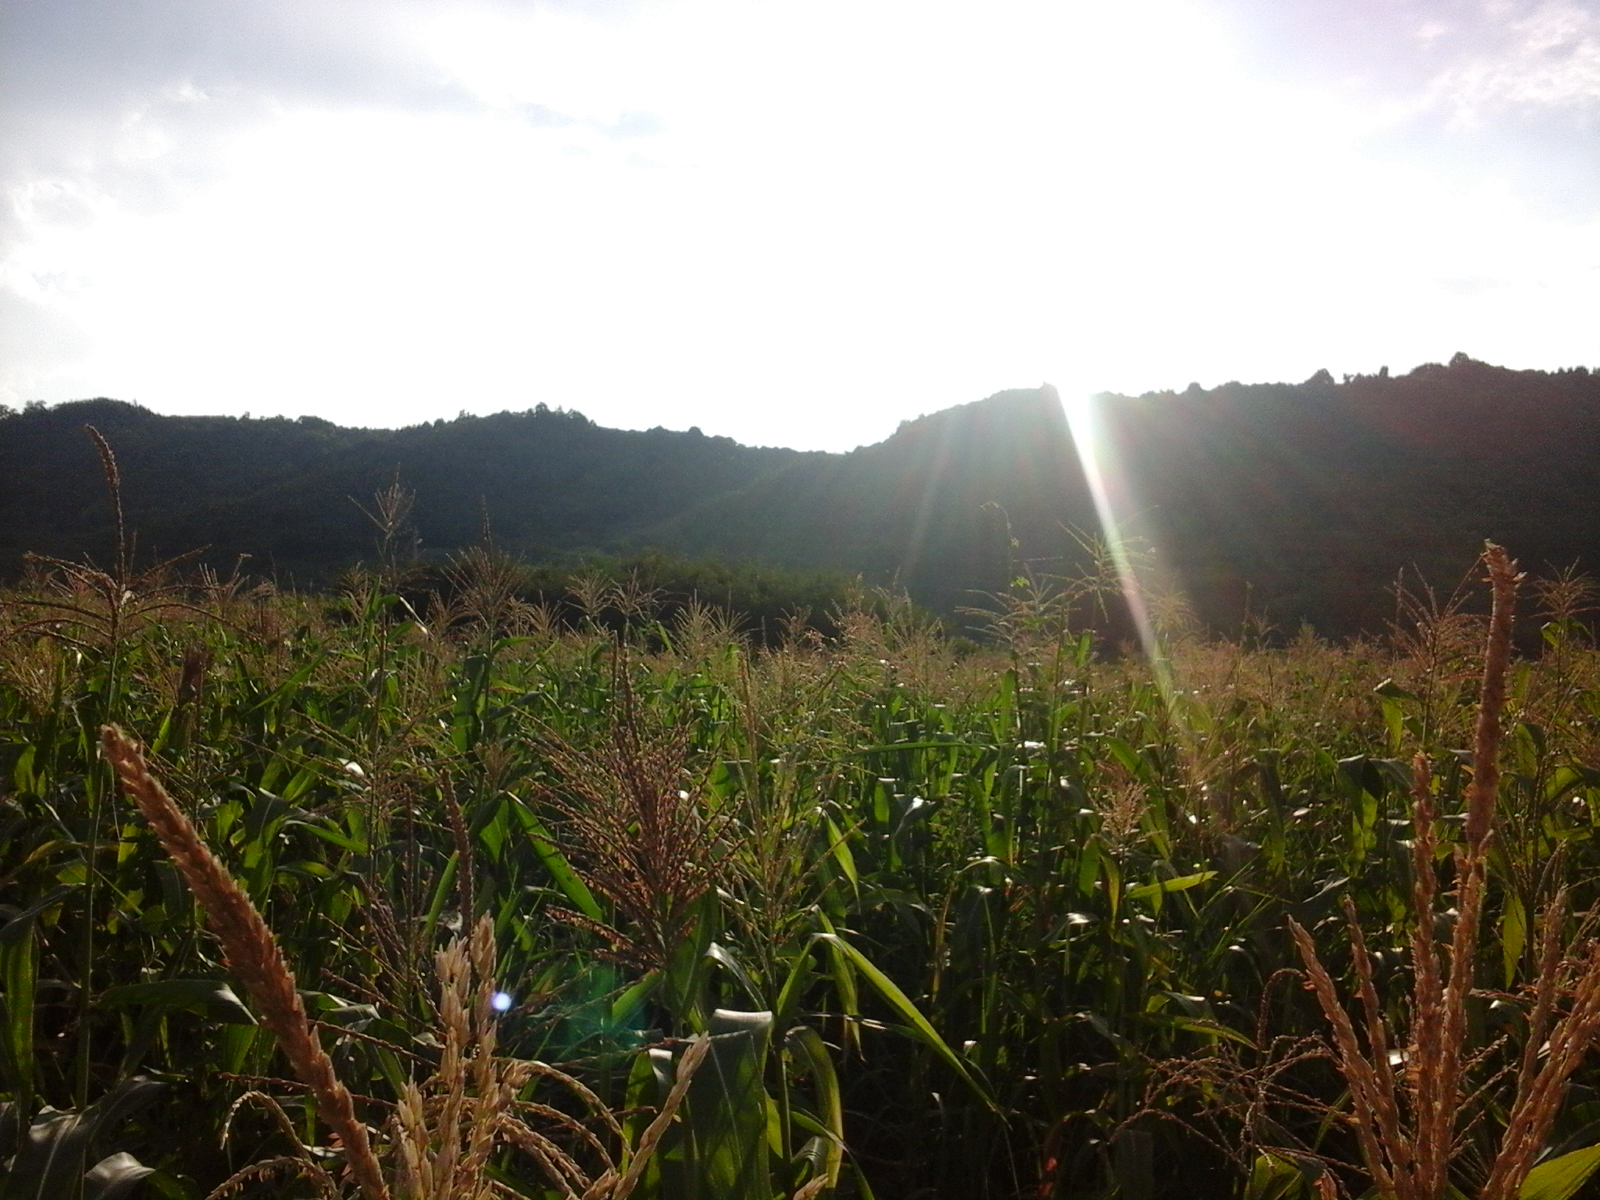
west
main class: Cropland
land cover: Maize
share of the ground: > 75 %
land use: Agriculture (excluding fallow land and kitchen gardens)
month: July
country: RO
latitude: 46.1966
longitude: 26.7378
